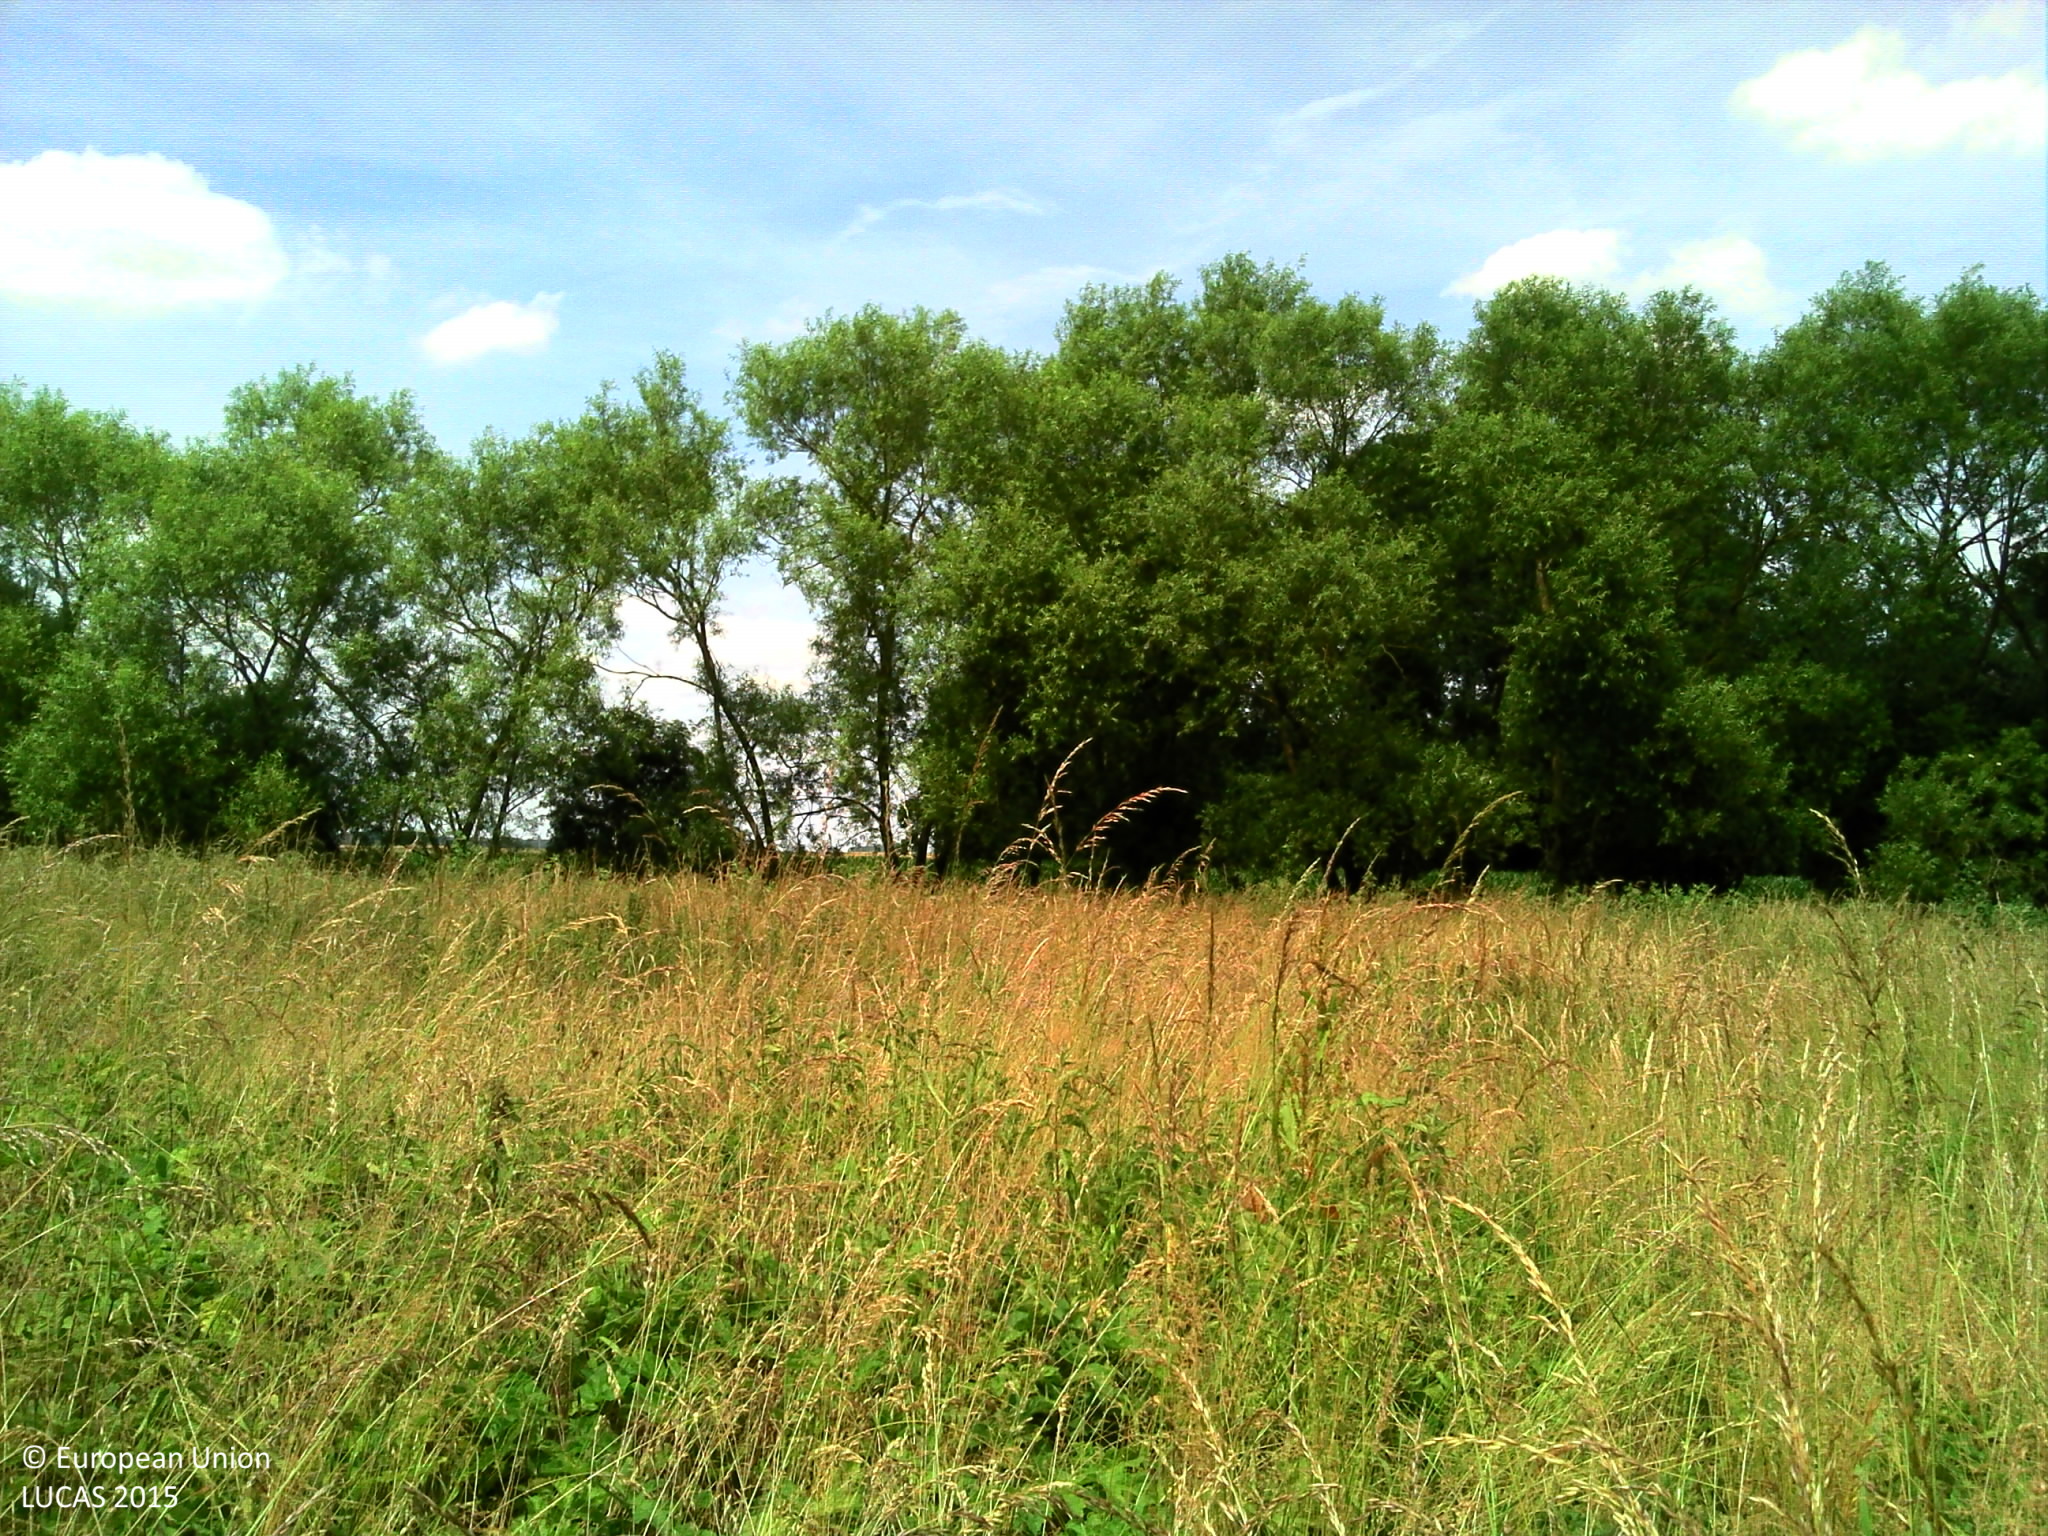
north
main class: Grassland
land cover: Grassland without tree/shrub cover
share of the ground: > 75 %
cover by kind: herbaceous plants 95 %, shrubs 5 %
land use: Agriculture (excluding fallow land and kitchen gardens)
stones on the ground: < 10 %
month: June
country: FR
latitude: 49.3456
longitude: 2.5694
